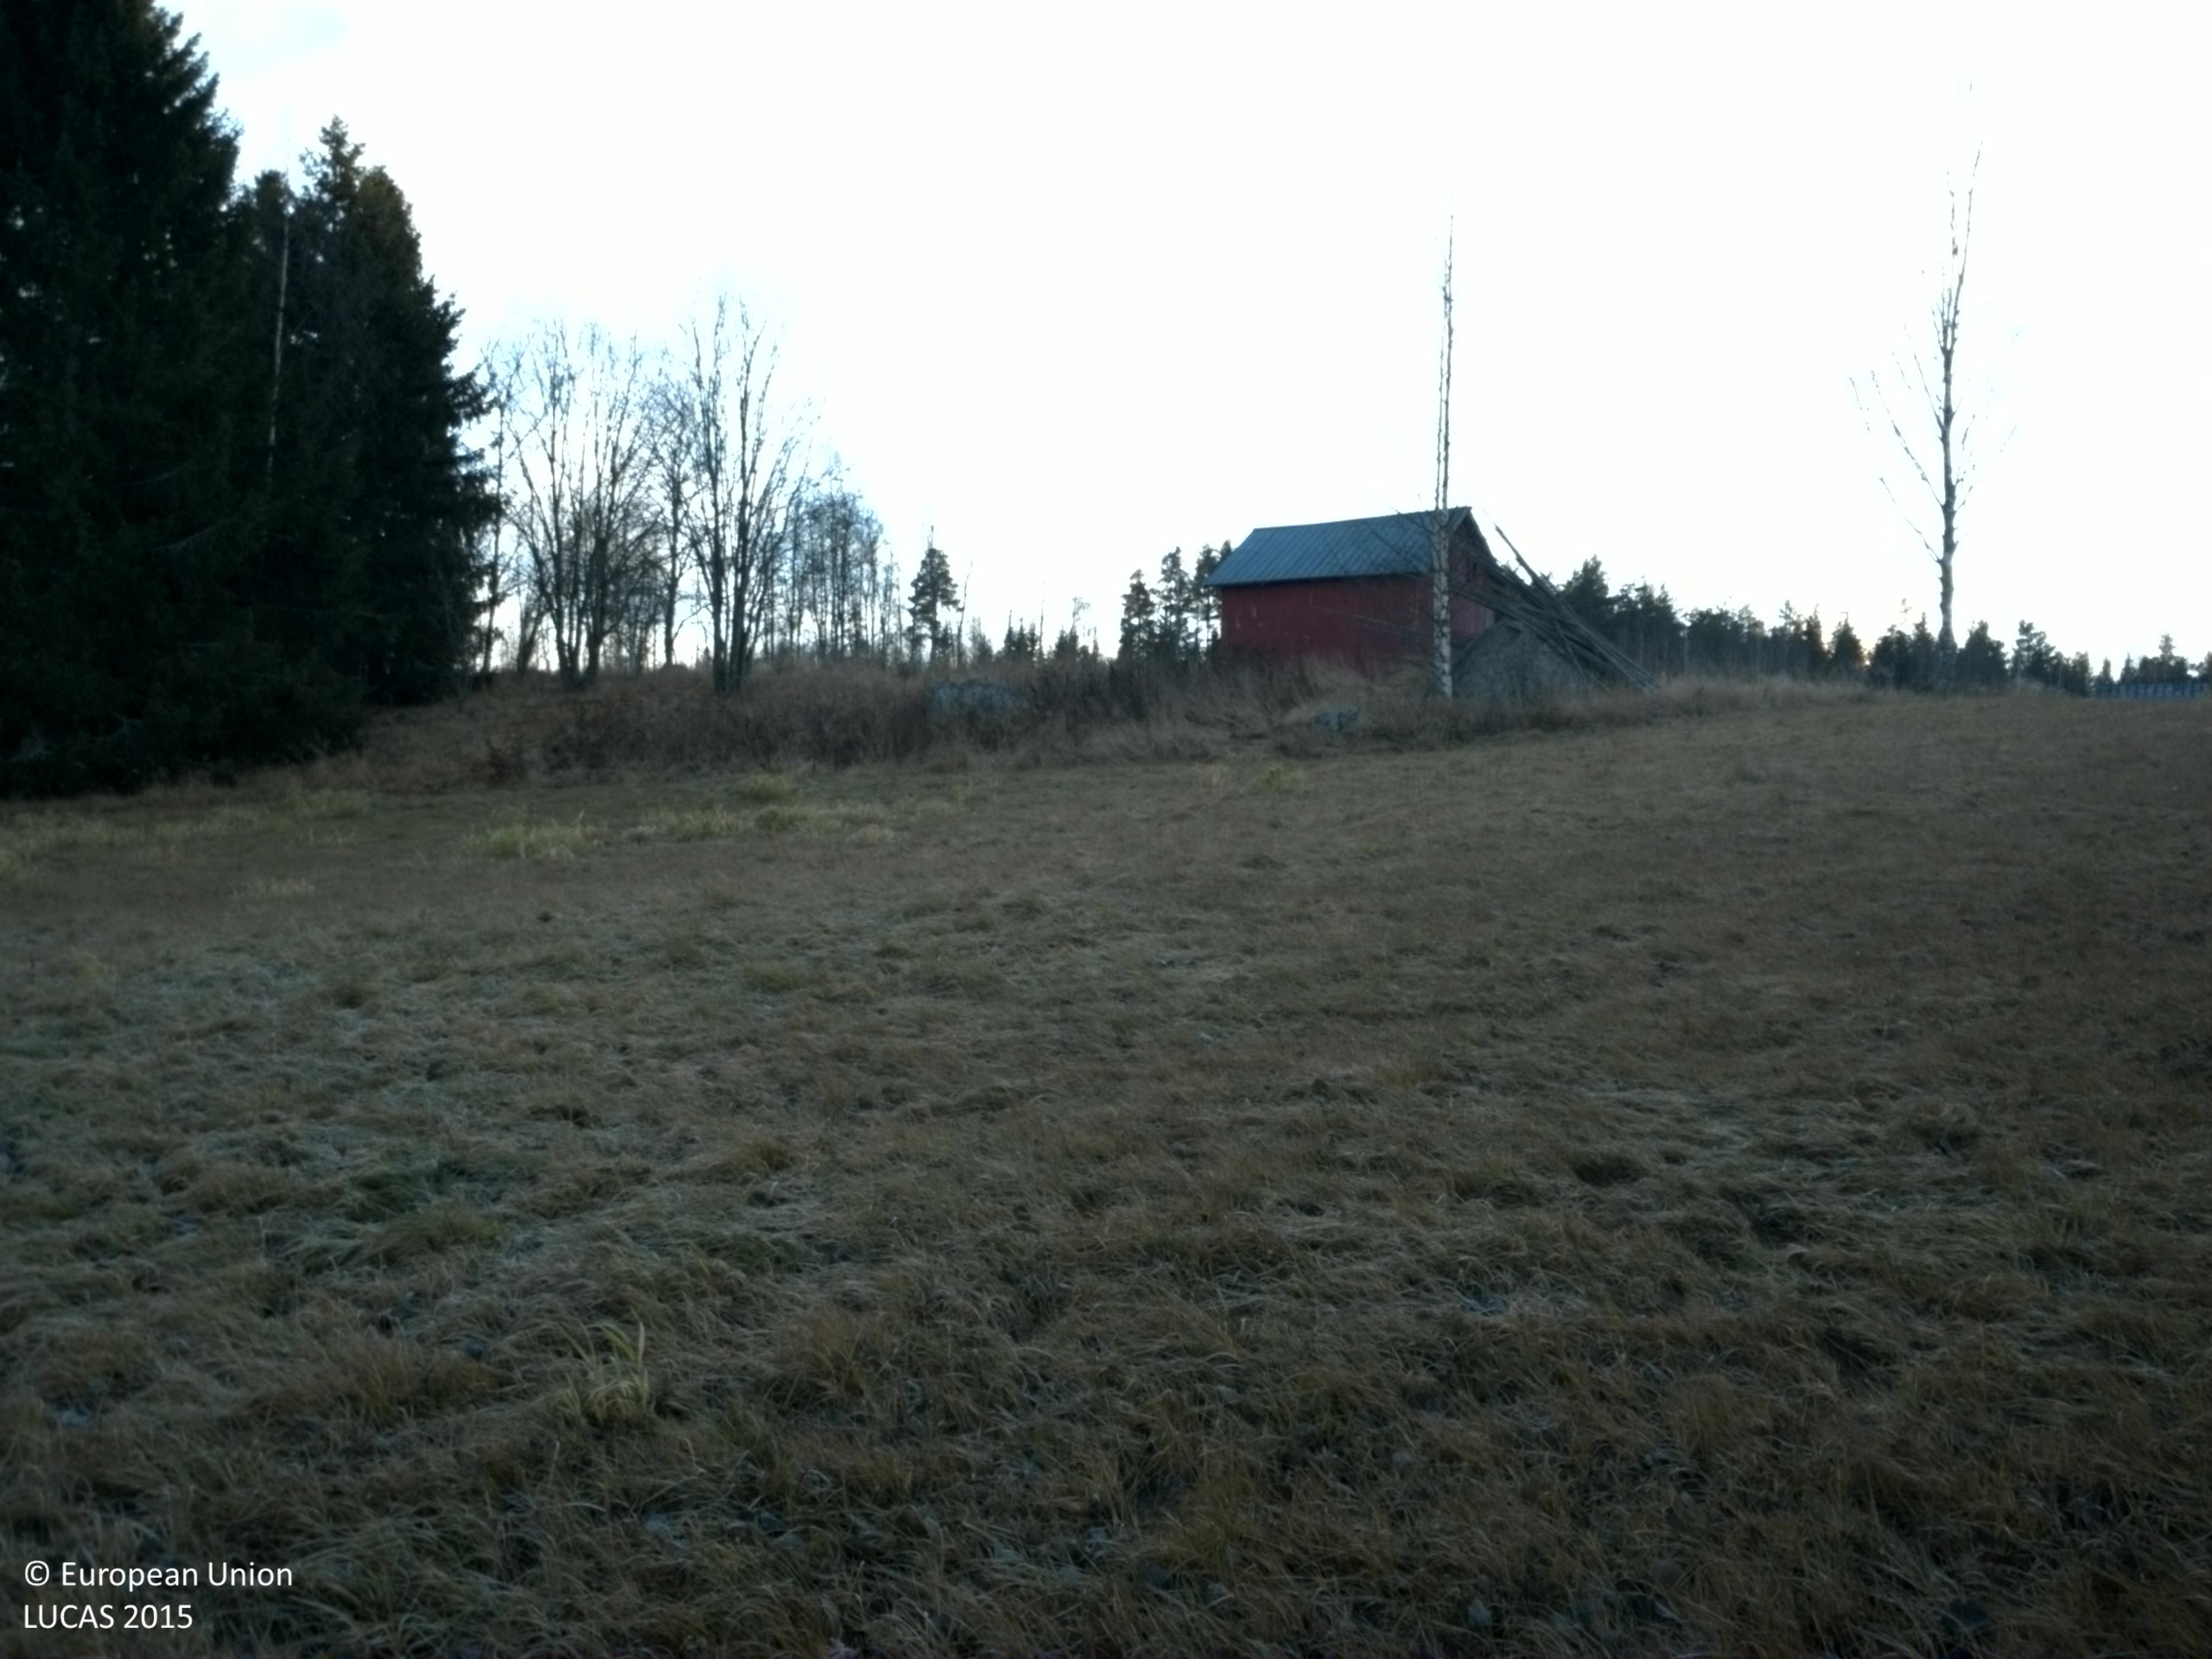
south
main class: Cropland
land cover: Temporary grasslands
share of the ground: > 75 %
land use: Agriculture (excluding fallow land and kitchen gardens)
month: November
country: SE
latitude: 61.2699
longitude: 16.6805
